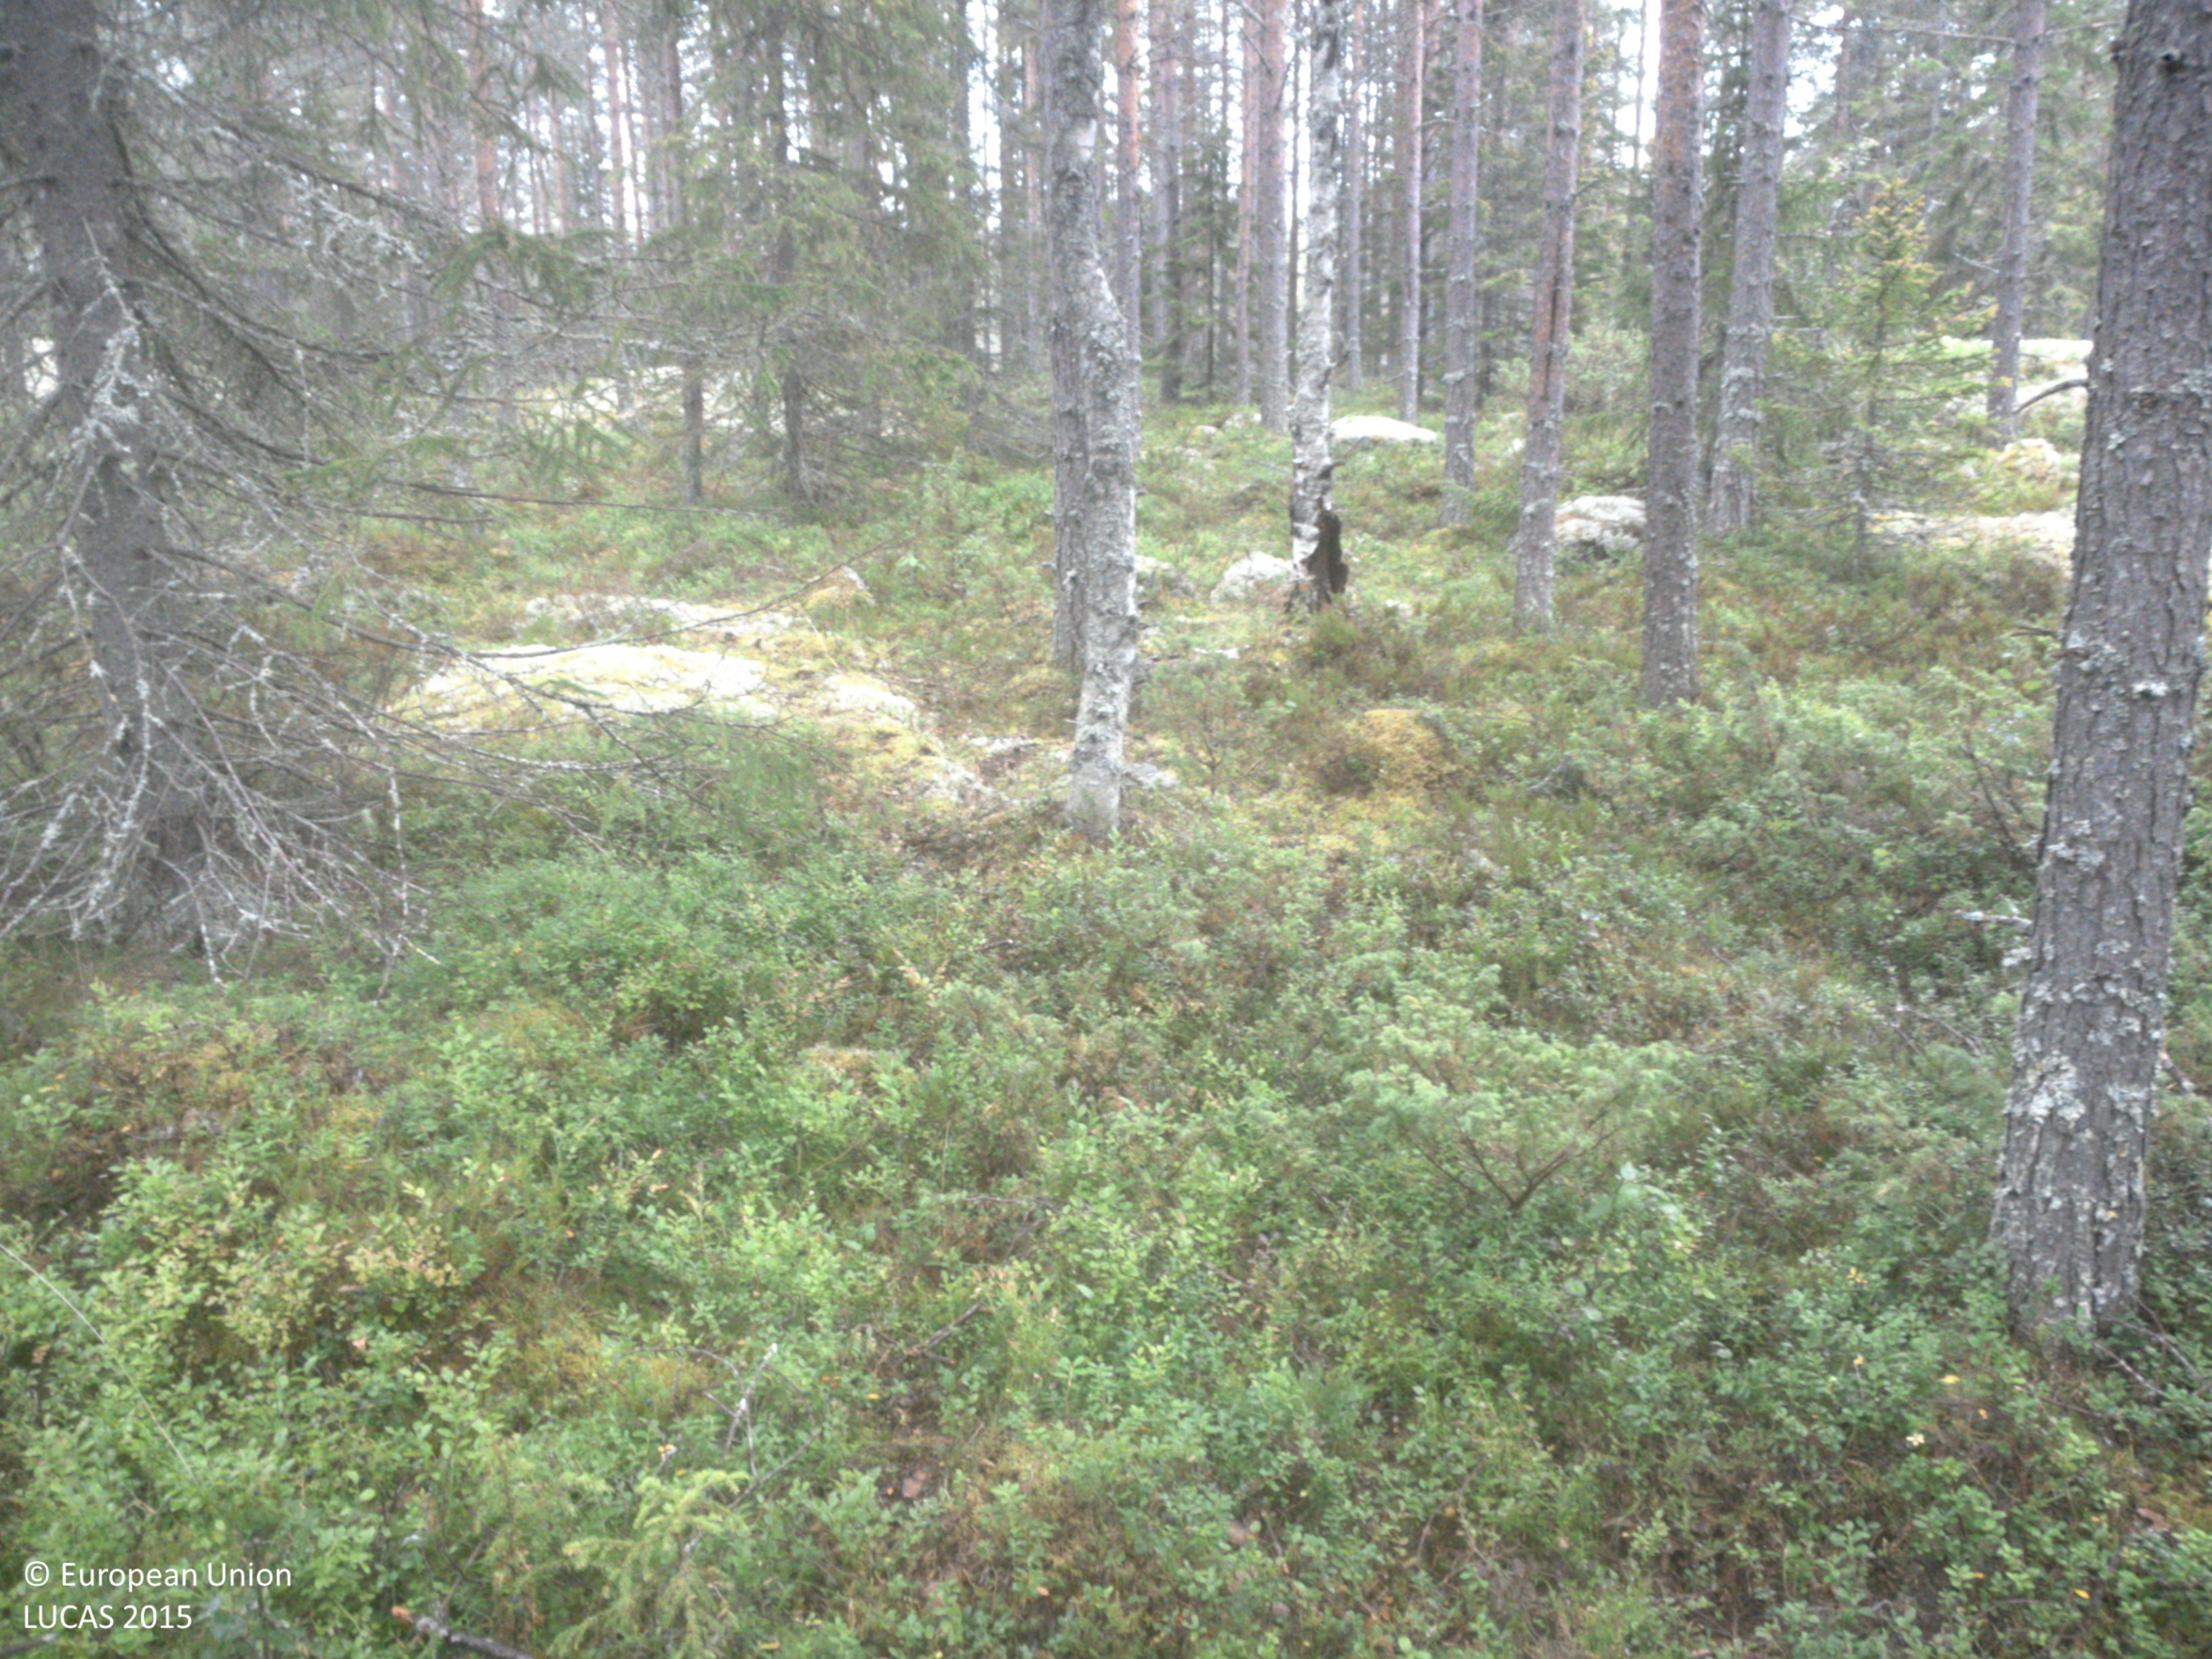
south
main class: Woodland
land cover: Other coniferous woodland
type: boreal forest
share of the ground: 50 - 75 %
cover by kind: coniferous forest trees 50 %, shrubs 50 %
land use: Forestry
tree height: > 5 m
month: August
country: SE
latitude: 63.7021
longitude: 19.9547
